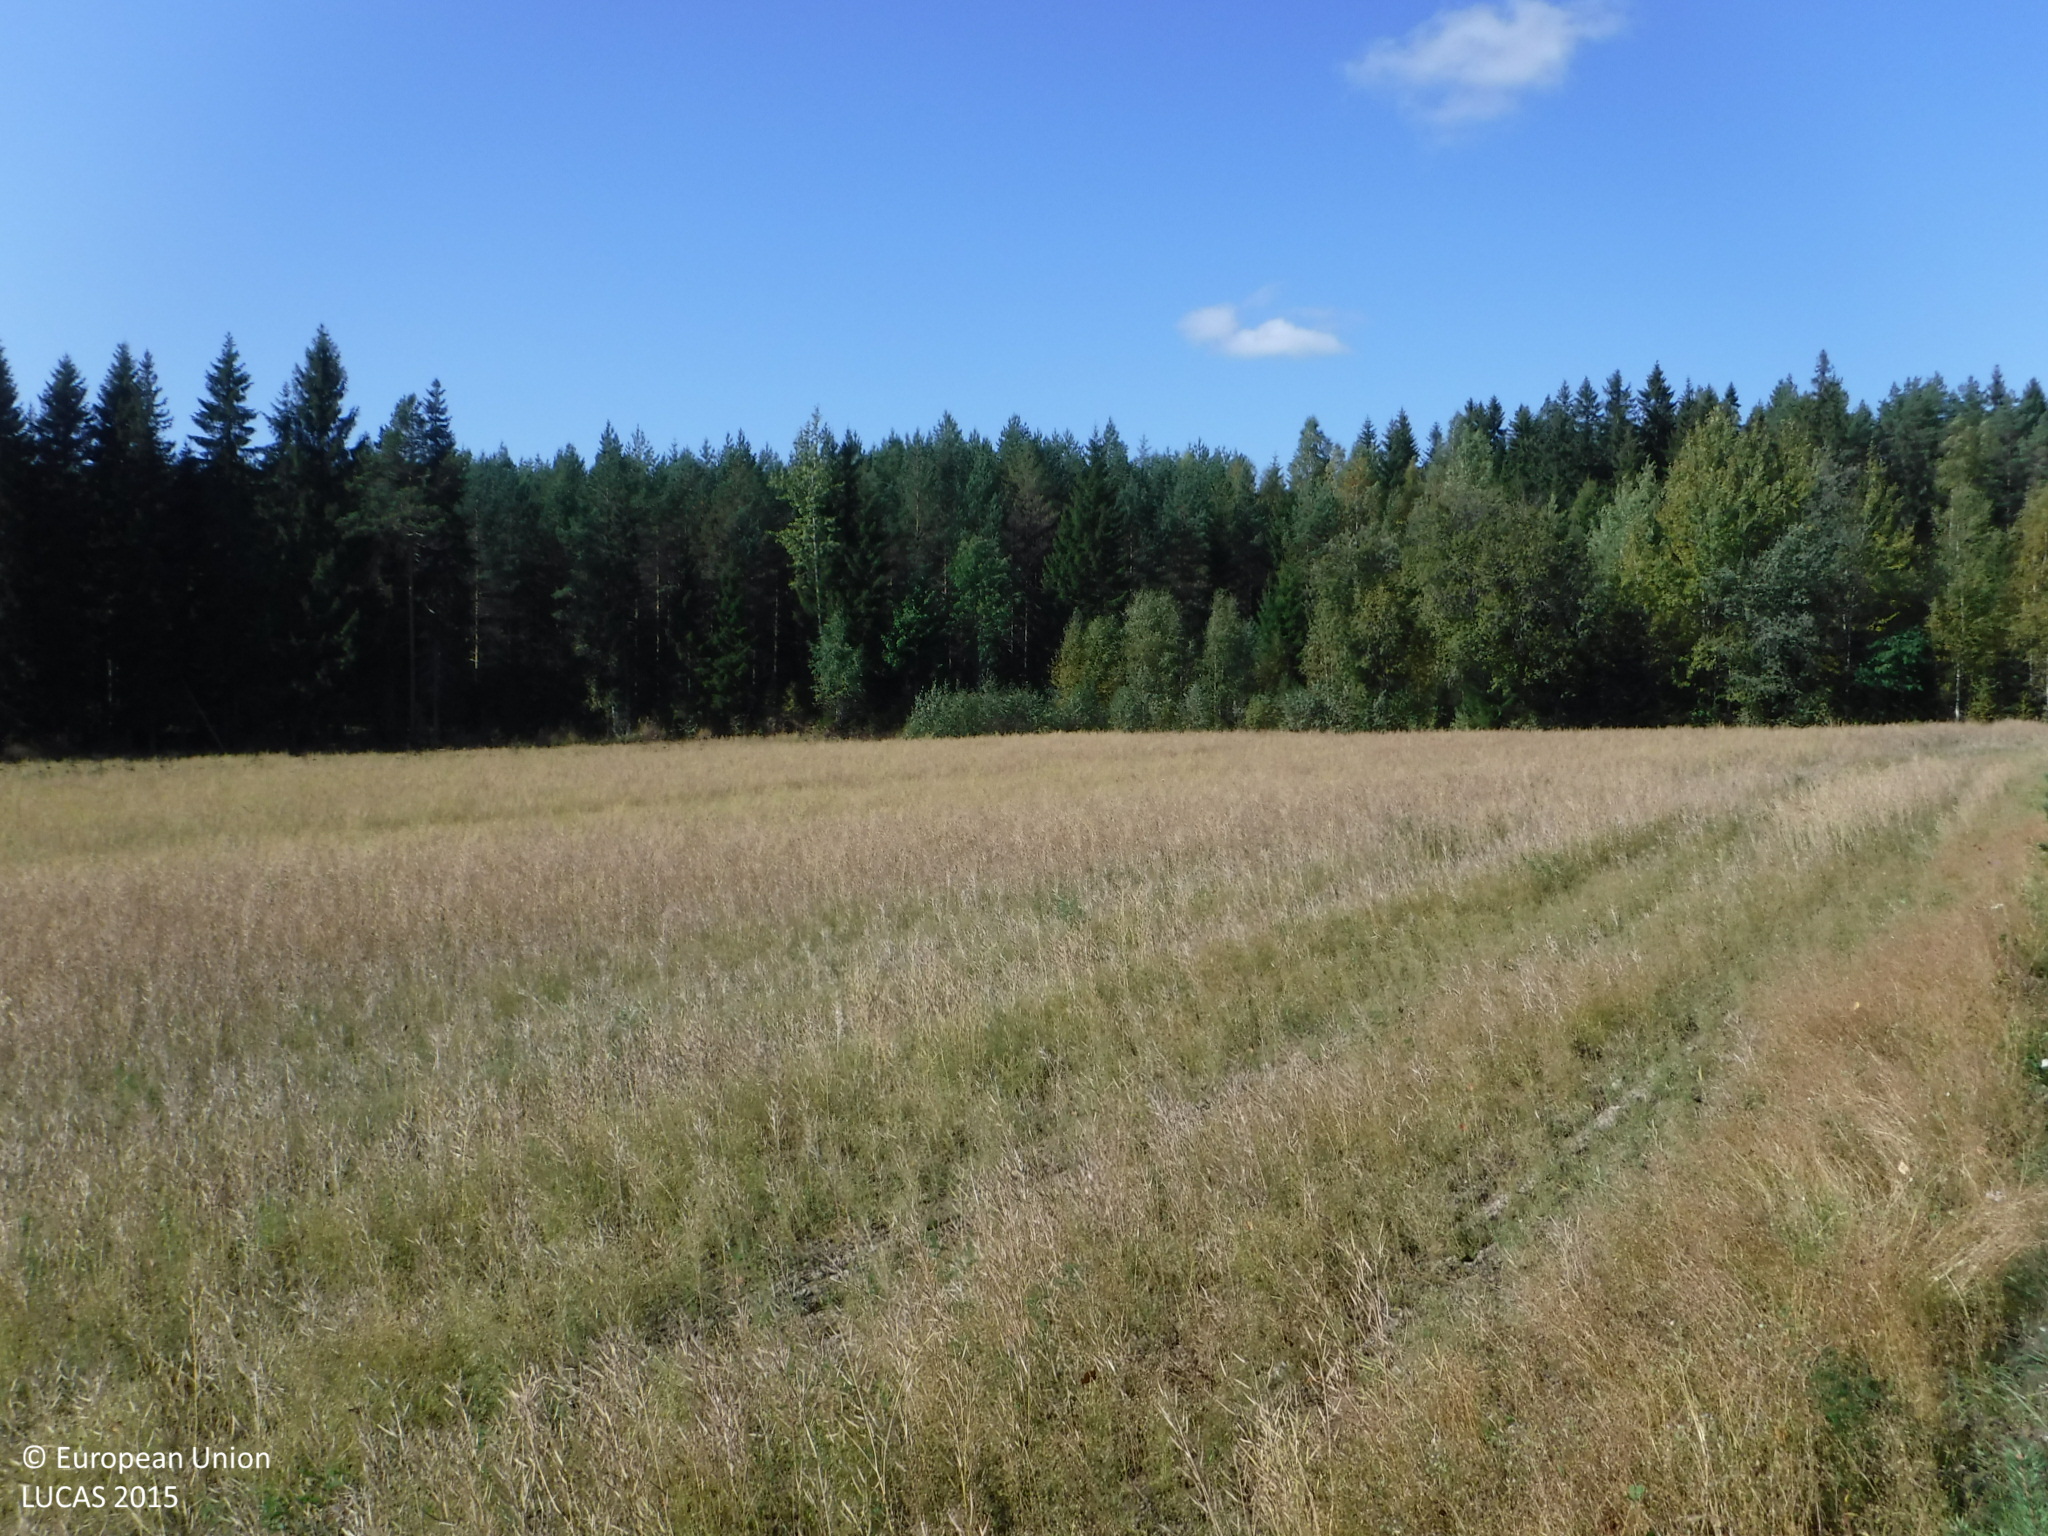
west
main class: Cropland
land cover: Rape and turnip rape
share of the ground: 50 - 75 %
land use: Agriculture (excluding fallow land and kitchen gardens)
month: September
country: FI
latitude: 61.8040
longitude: 22.8343
